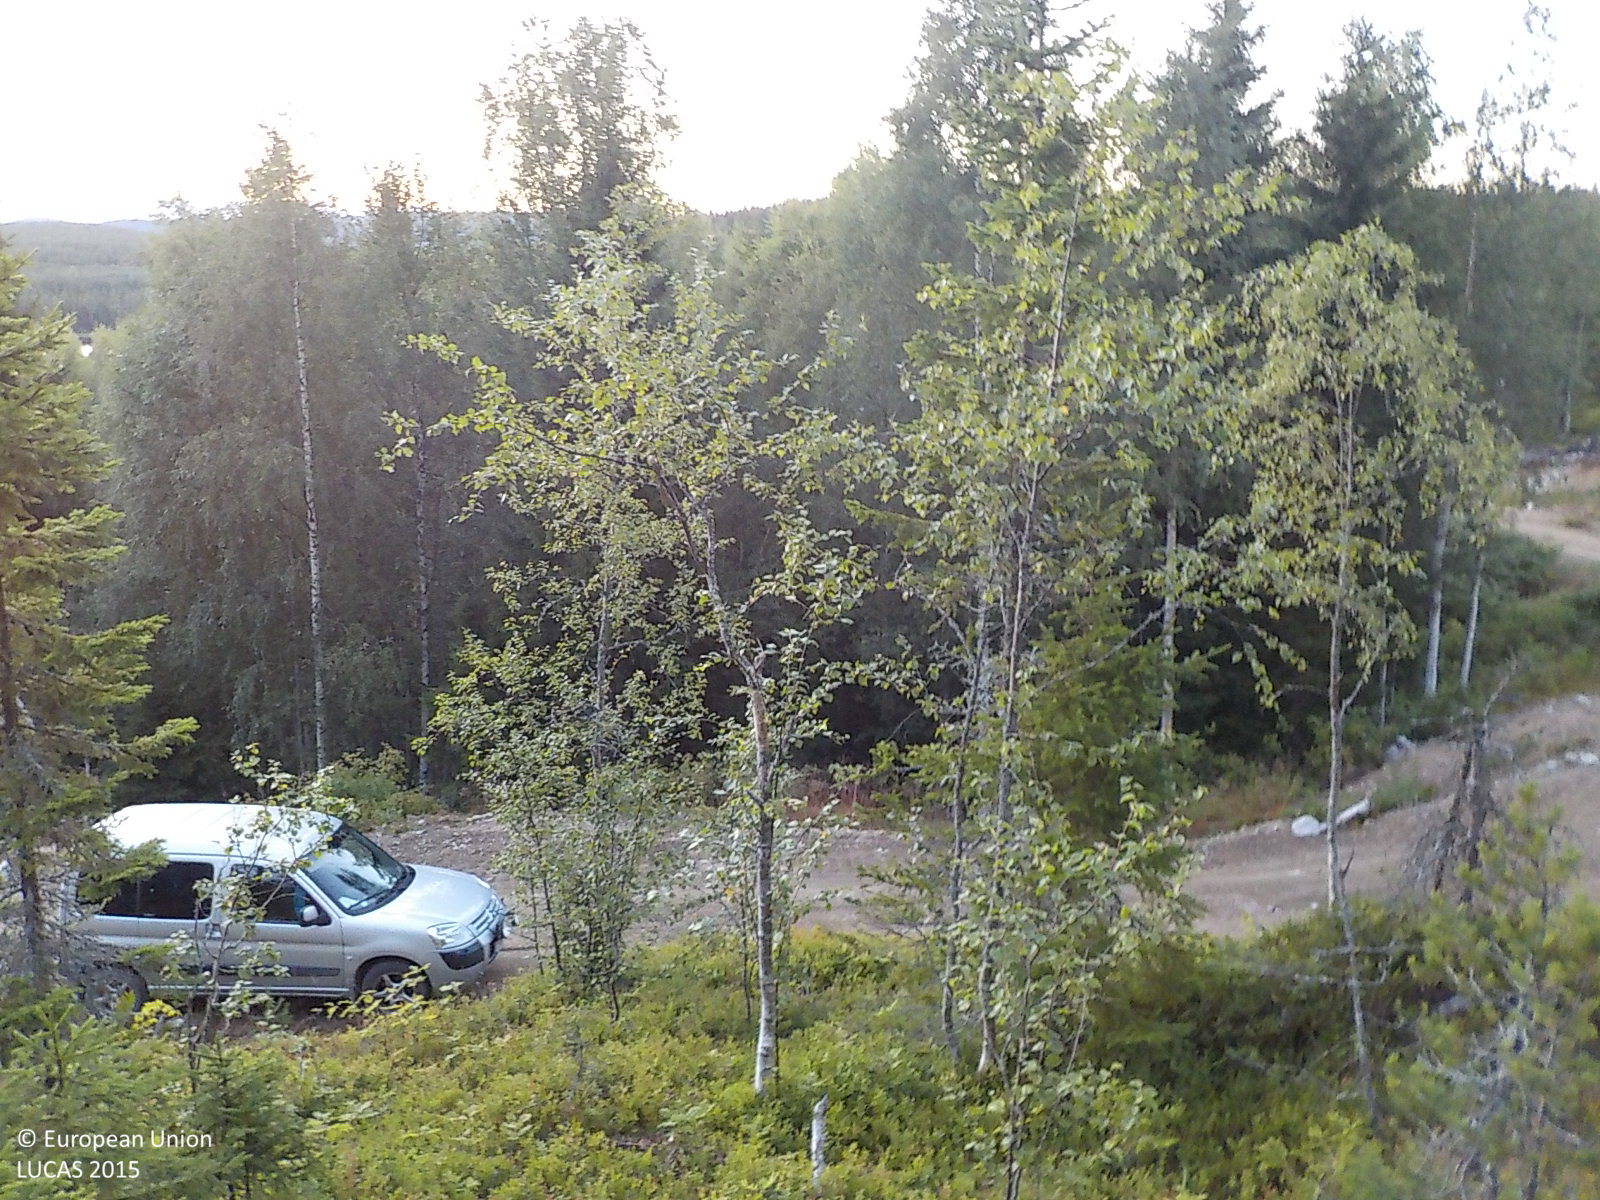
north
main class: Woodland
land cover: Pine dominated mixed woodland
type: boreal forest
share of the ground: 10 - 25 %
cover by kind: shrubs 80 %, coniferous forest trees 15 %, broadleaved forest trees 5 %
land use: Forestry
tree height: > 5 m
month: August
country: SE
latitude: 63.4792
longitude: 18.8296
